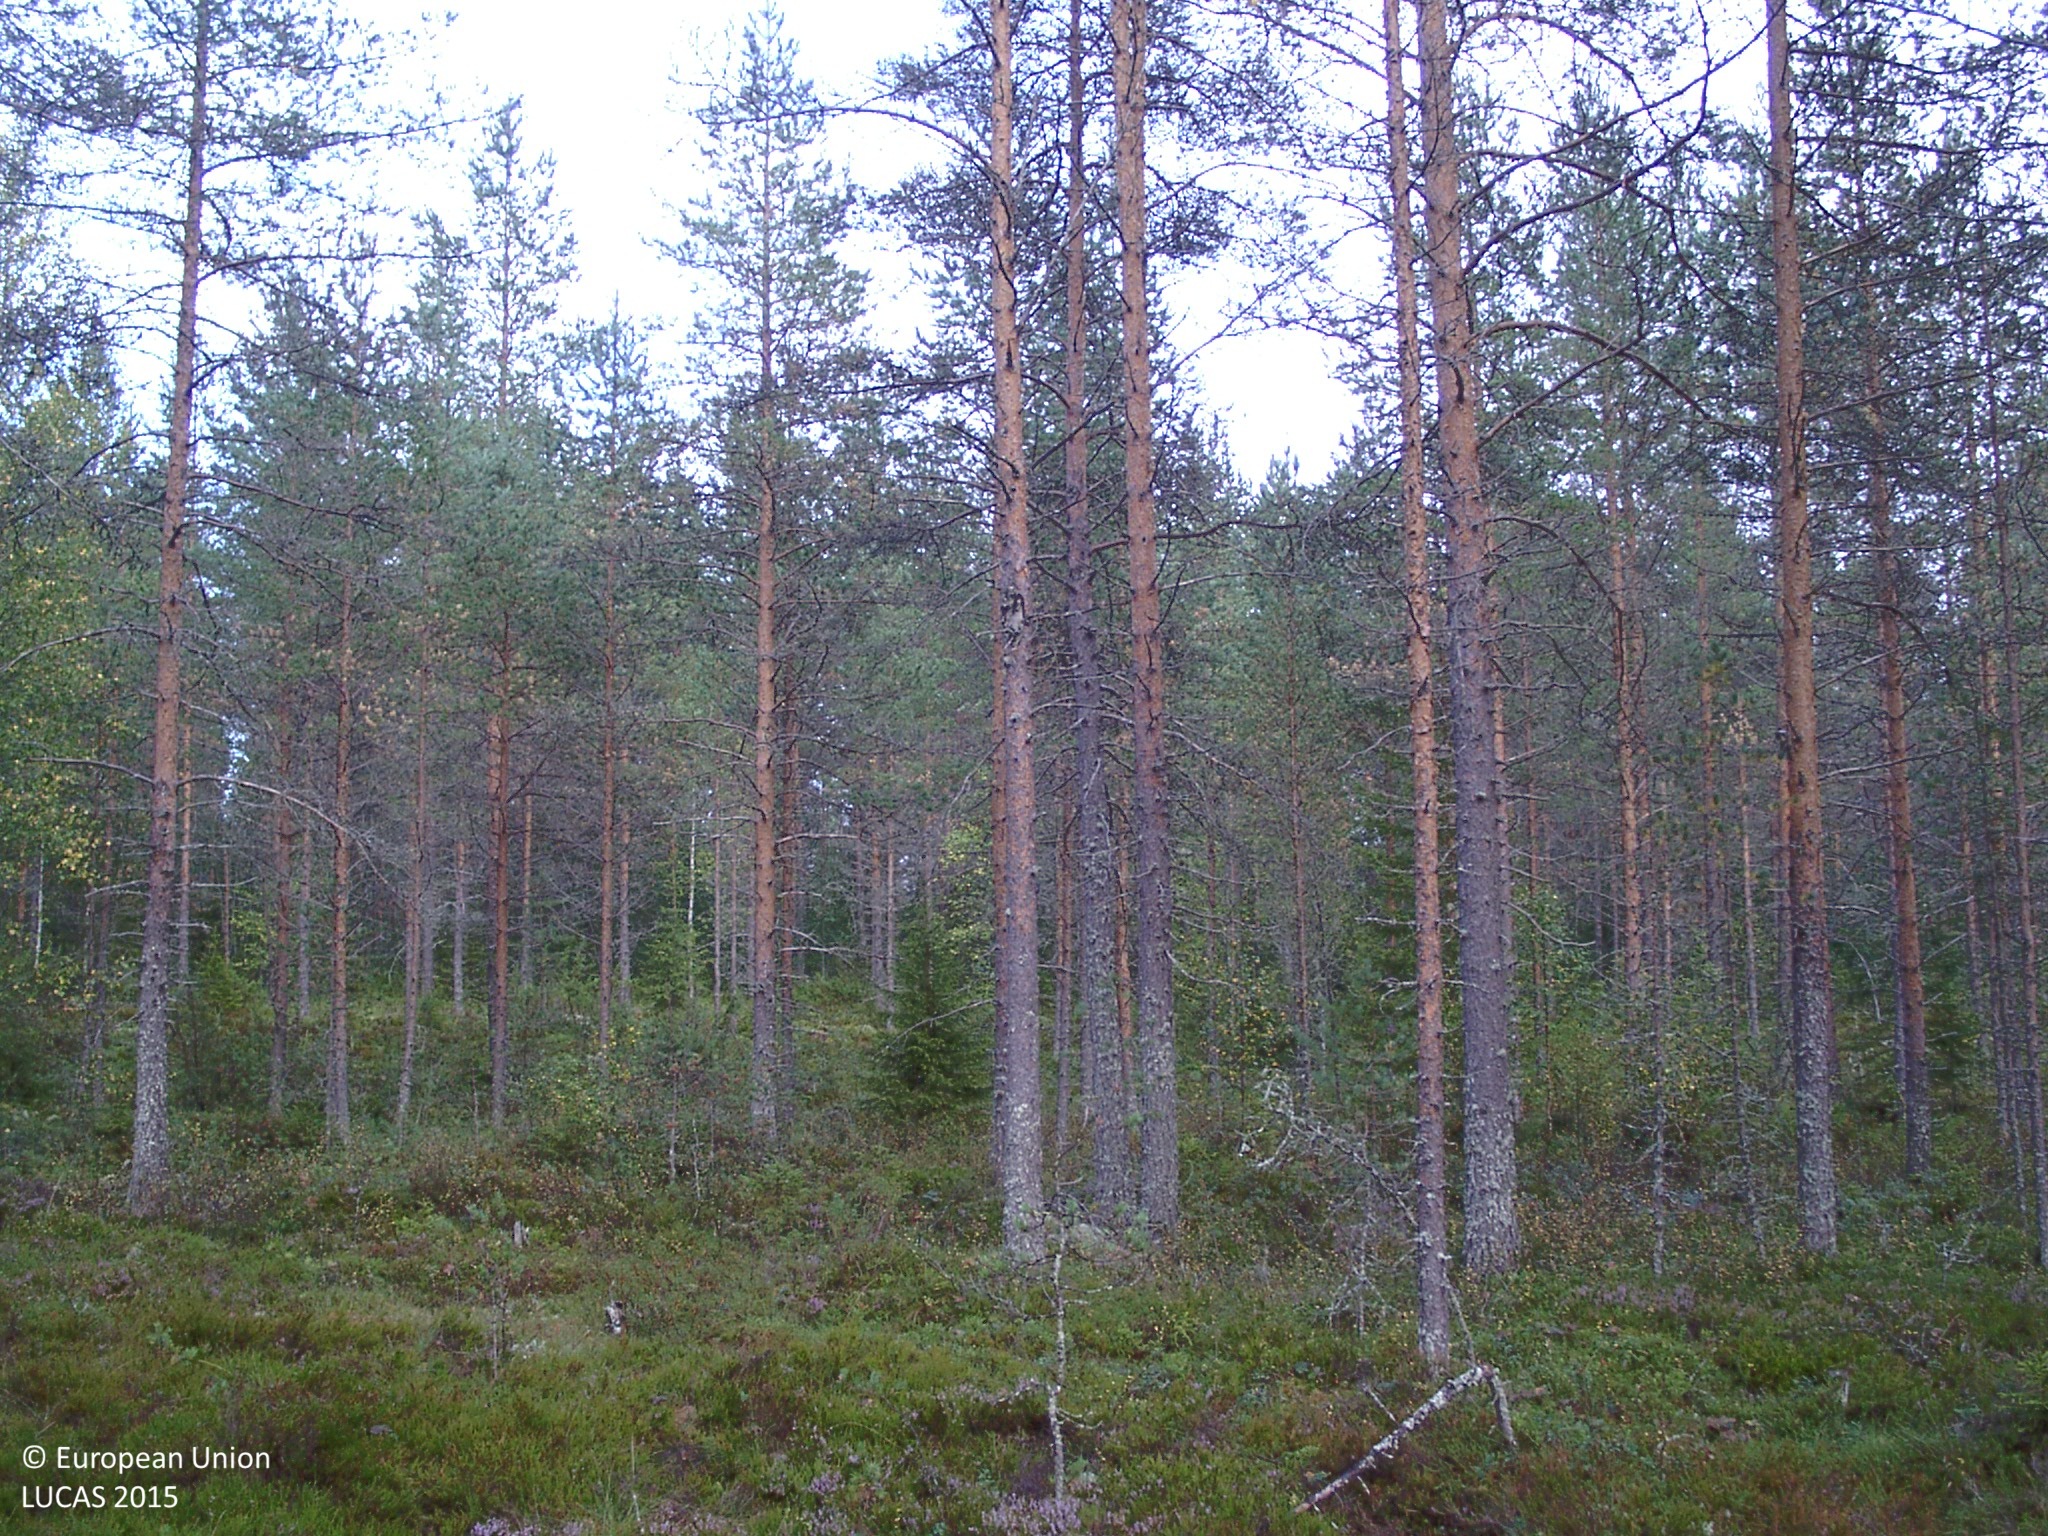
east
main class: Woodland
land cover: Pine dominated coniferous woodland
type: mire and swamp forests
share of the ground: 25 - 50 %
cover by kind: coniferous forest trees 40 %, shrubs 40 %, lichens and mosses 15 %, herbaceous plants 5 %
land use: Forestry
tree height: > 5 m
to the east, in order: Pine dominated coniferous woodland; Shruby margins; Ditches and canals; Pine dominated coniferous woodland; Shruby margins; Pine dominated mixed woodland; Pine dominated coniferous woodland; Shruby margins; Pine dominated coniferous woodland; Other mixed woodland; Ditches and canals; Pine dominated mixed woodland; Ditches and canals; Pine dominated coniferous woodland
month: August
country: FI
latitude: 62.3952
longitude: 24.9373
